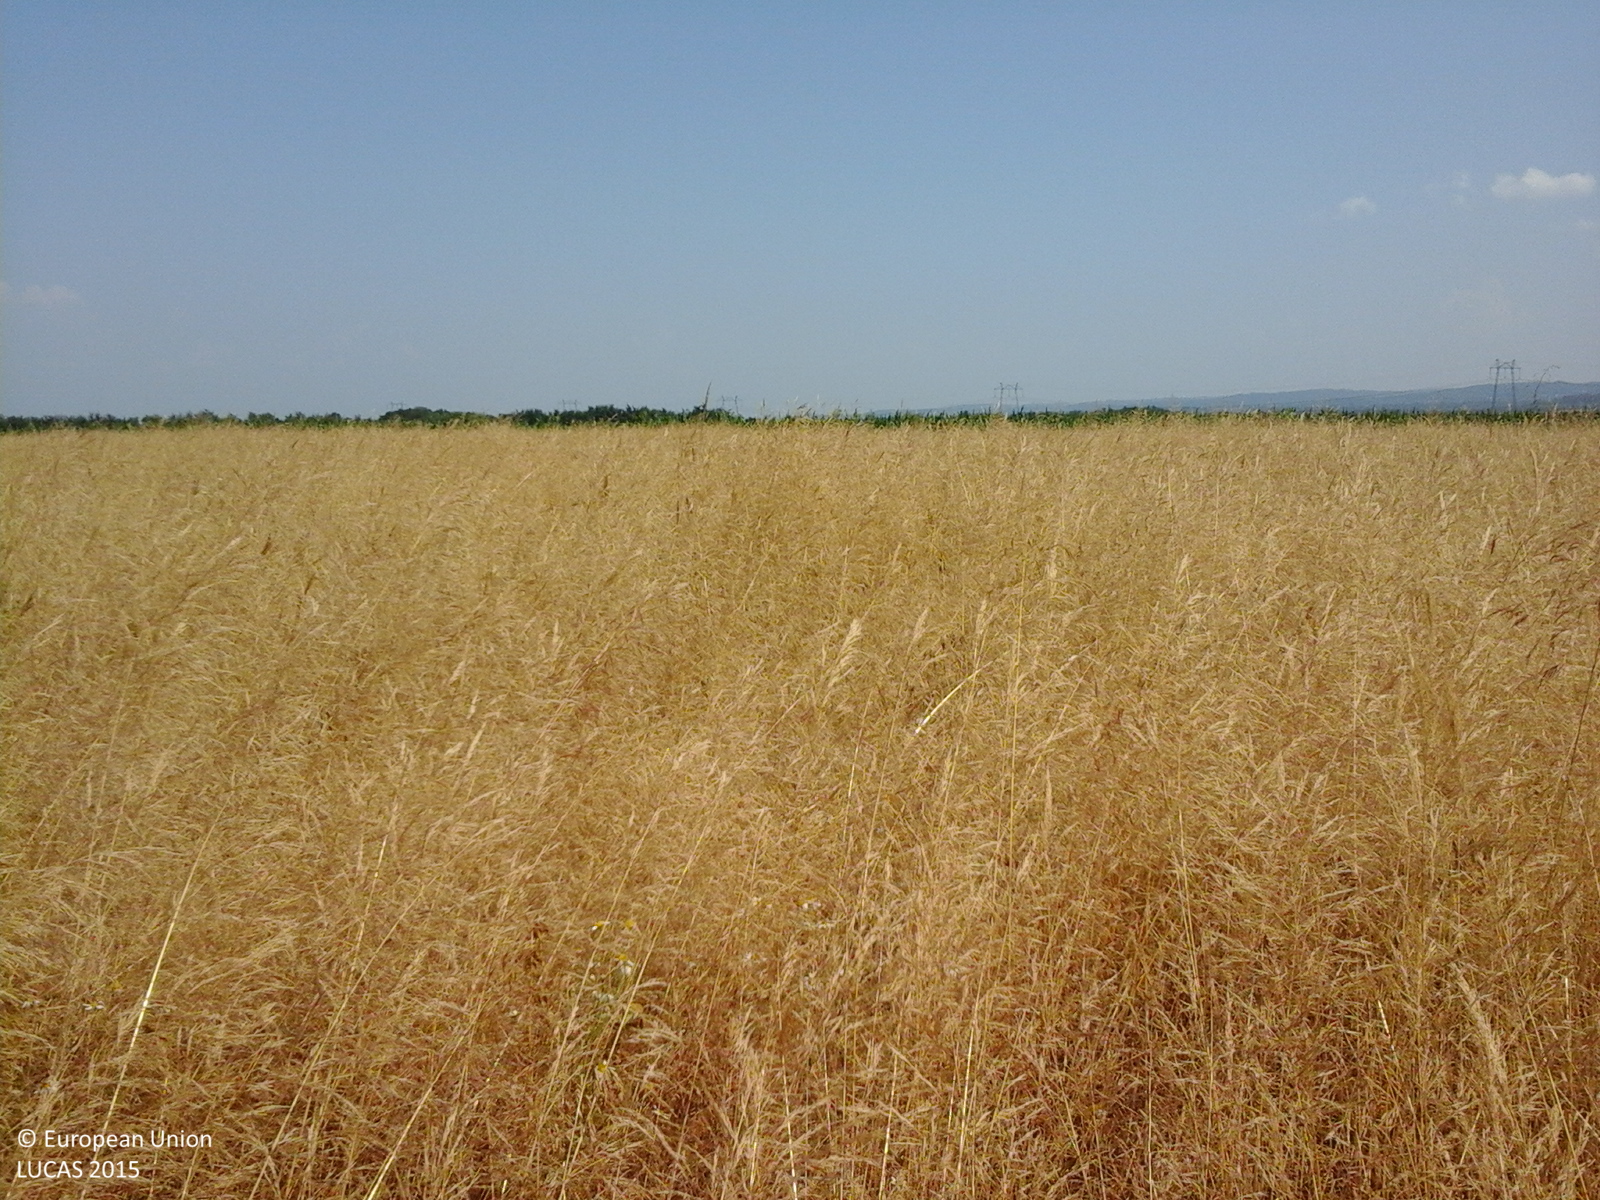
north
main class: Cropland
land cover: Mixed cereals for fodder
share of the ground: > 75 %
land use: Agriculture (excluding fallow land and kitchen gardens)
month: July
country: RO
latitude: 44.8356
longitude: 24.3012
